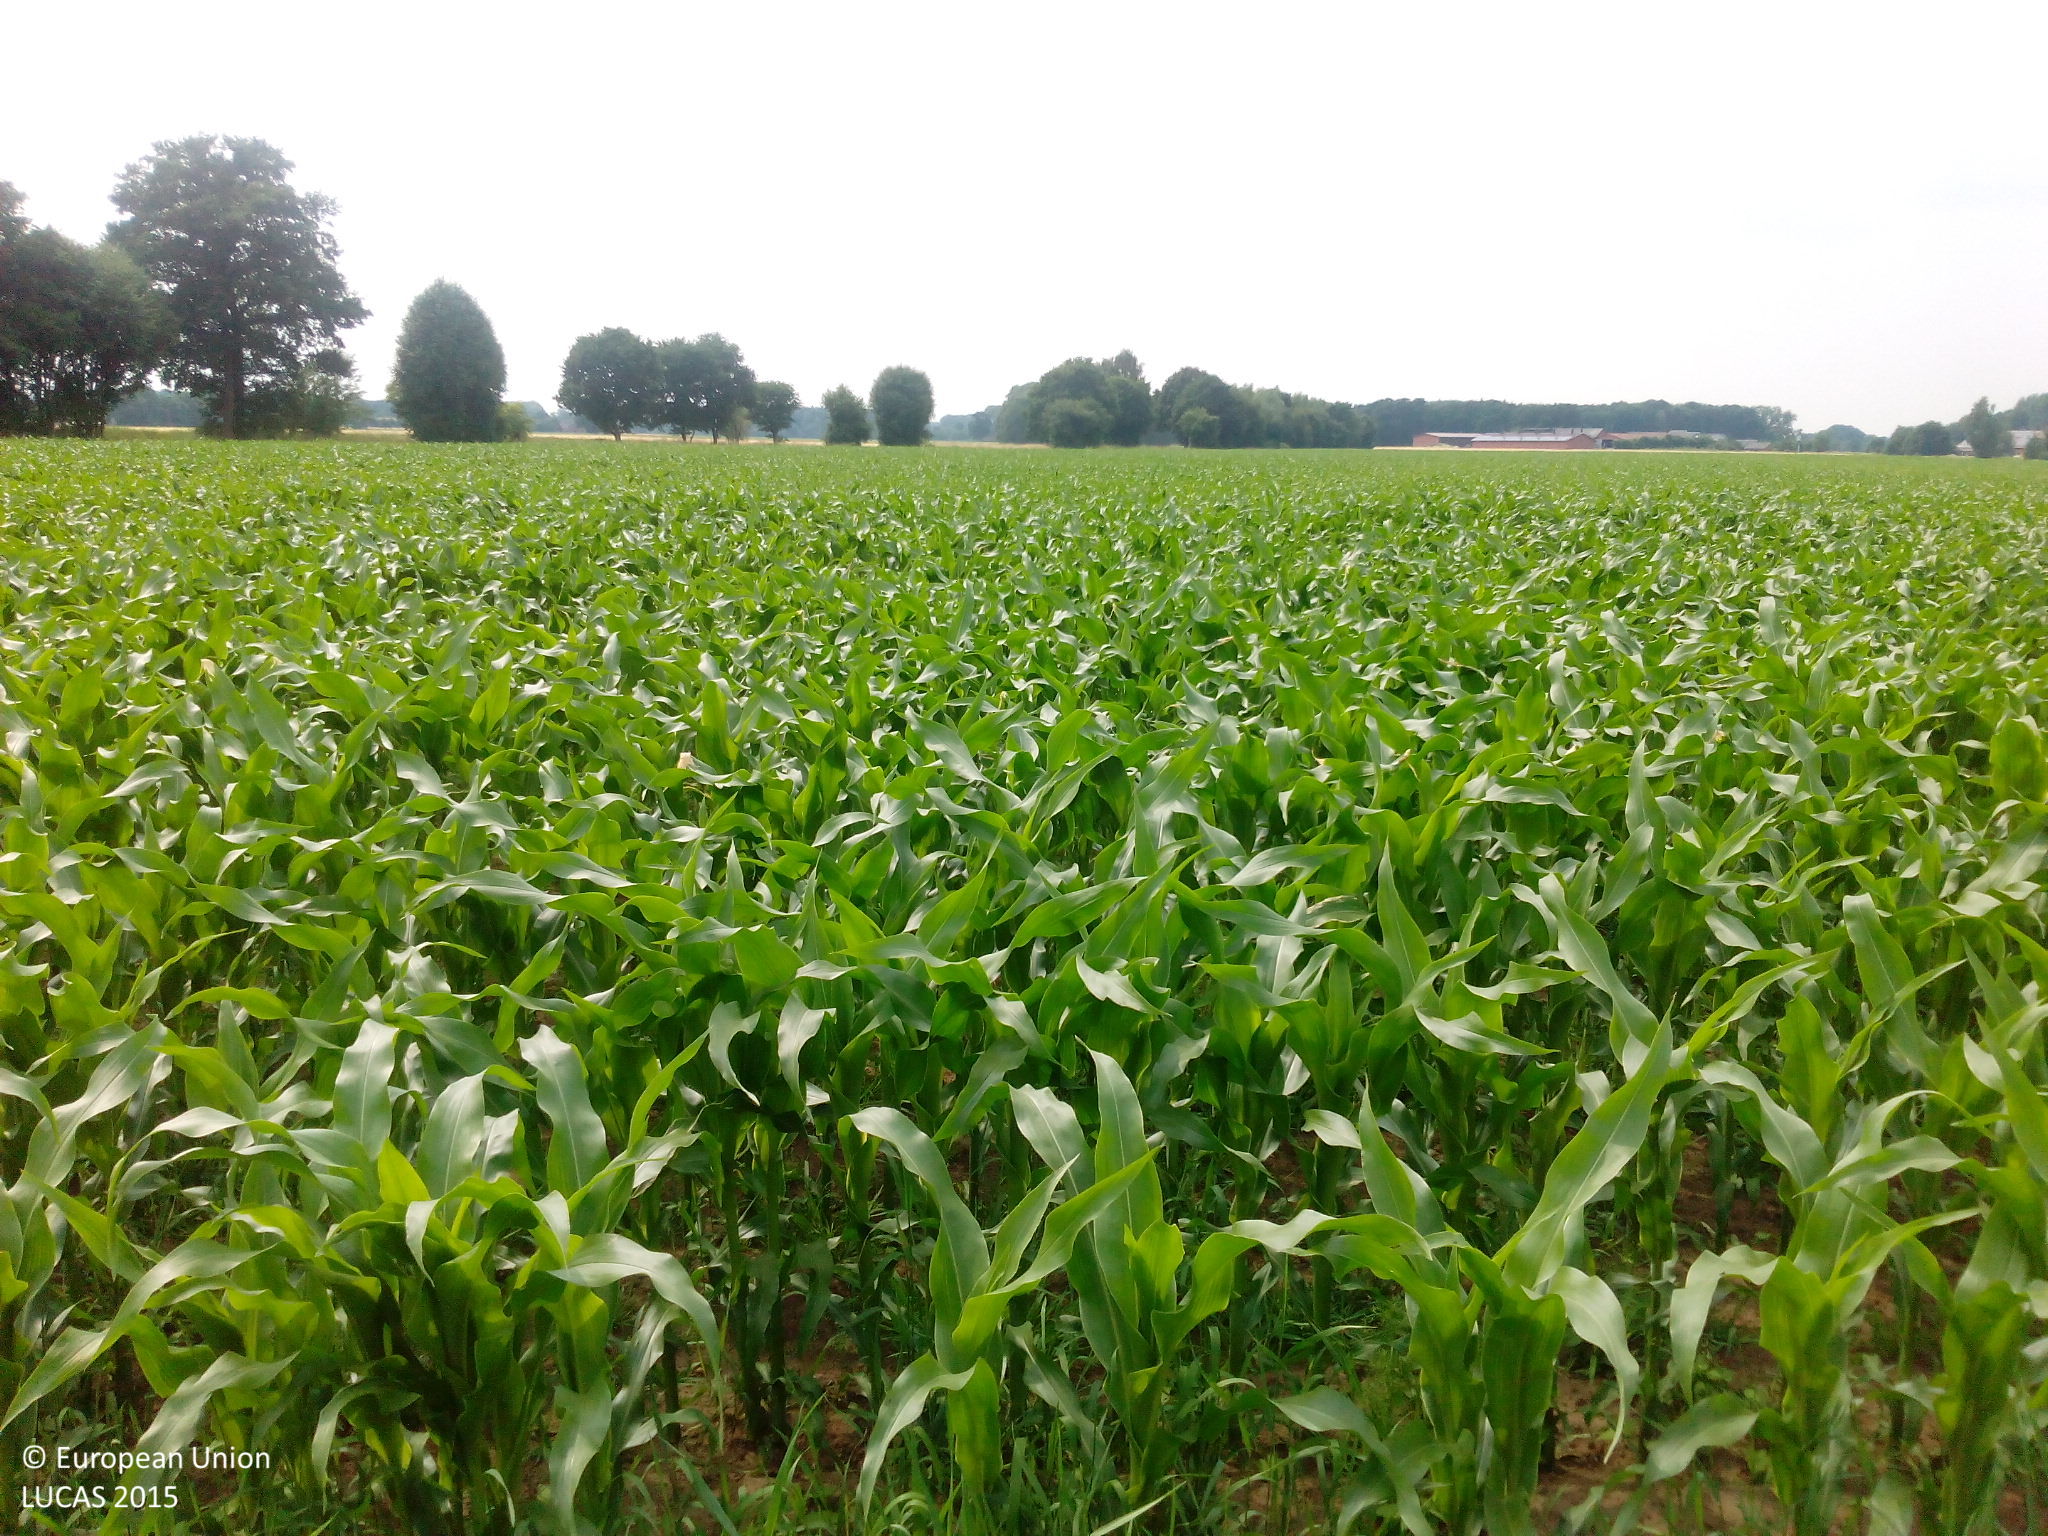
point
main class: Cropland
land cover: Maize
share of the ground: > 75 %
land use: Agriculture (excluding fallow land and kitchen gardens)
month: June
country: DE
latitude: 51.7741
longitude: 8.4497
